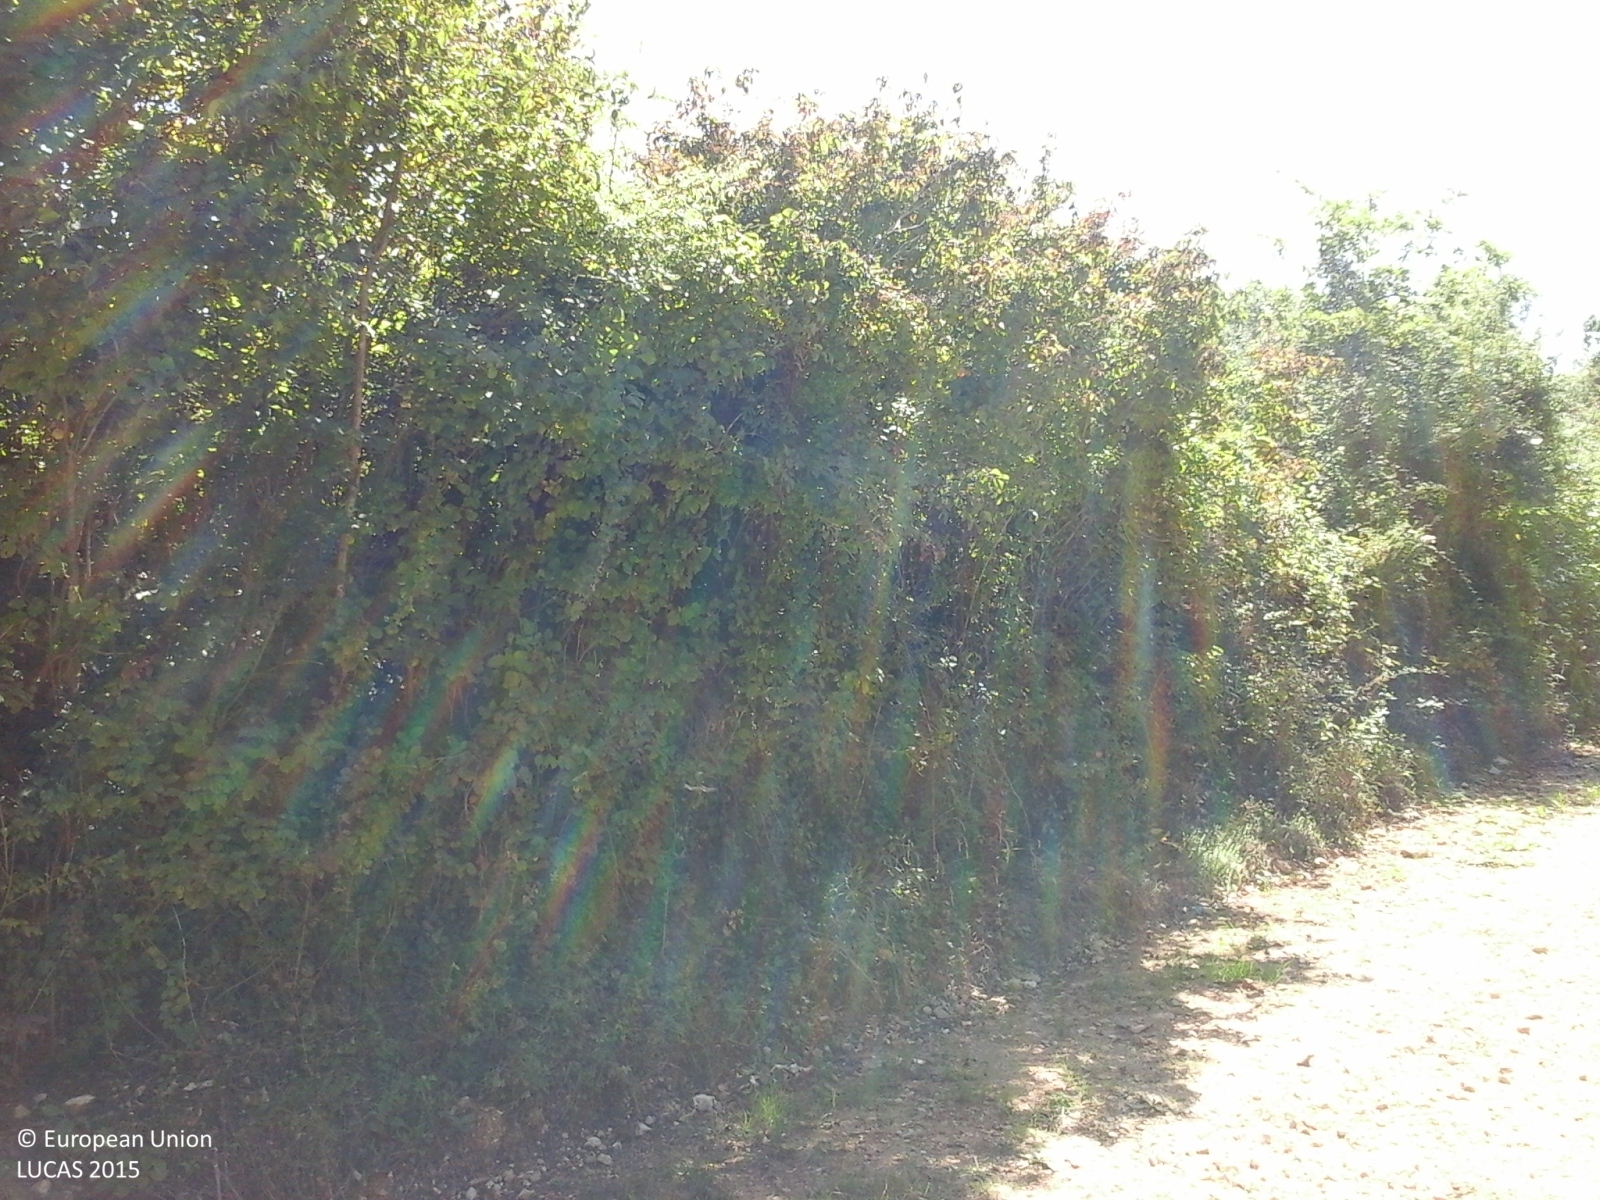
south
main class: Woodland
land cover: Broadleaved woodland
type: thermophilous deciduous forest
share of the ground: > 75 %
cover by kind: broadleaved forest trees 80 %, herbaceous plants 15 %, shrubs 5 %
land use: Semi-natural and natural areas not in use
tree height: > 5 m
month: September
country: GR
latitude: 39.7580
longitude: 20.6584
